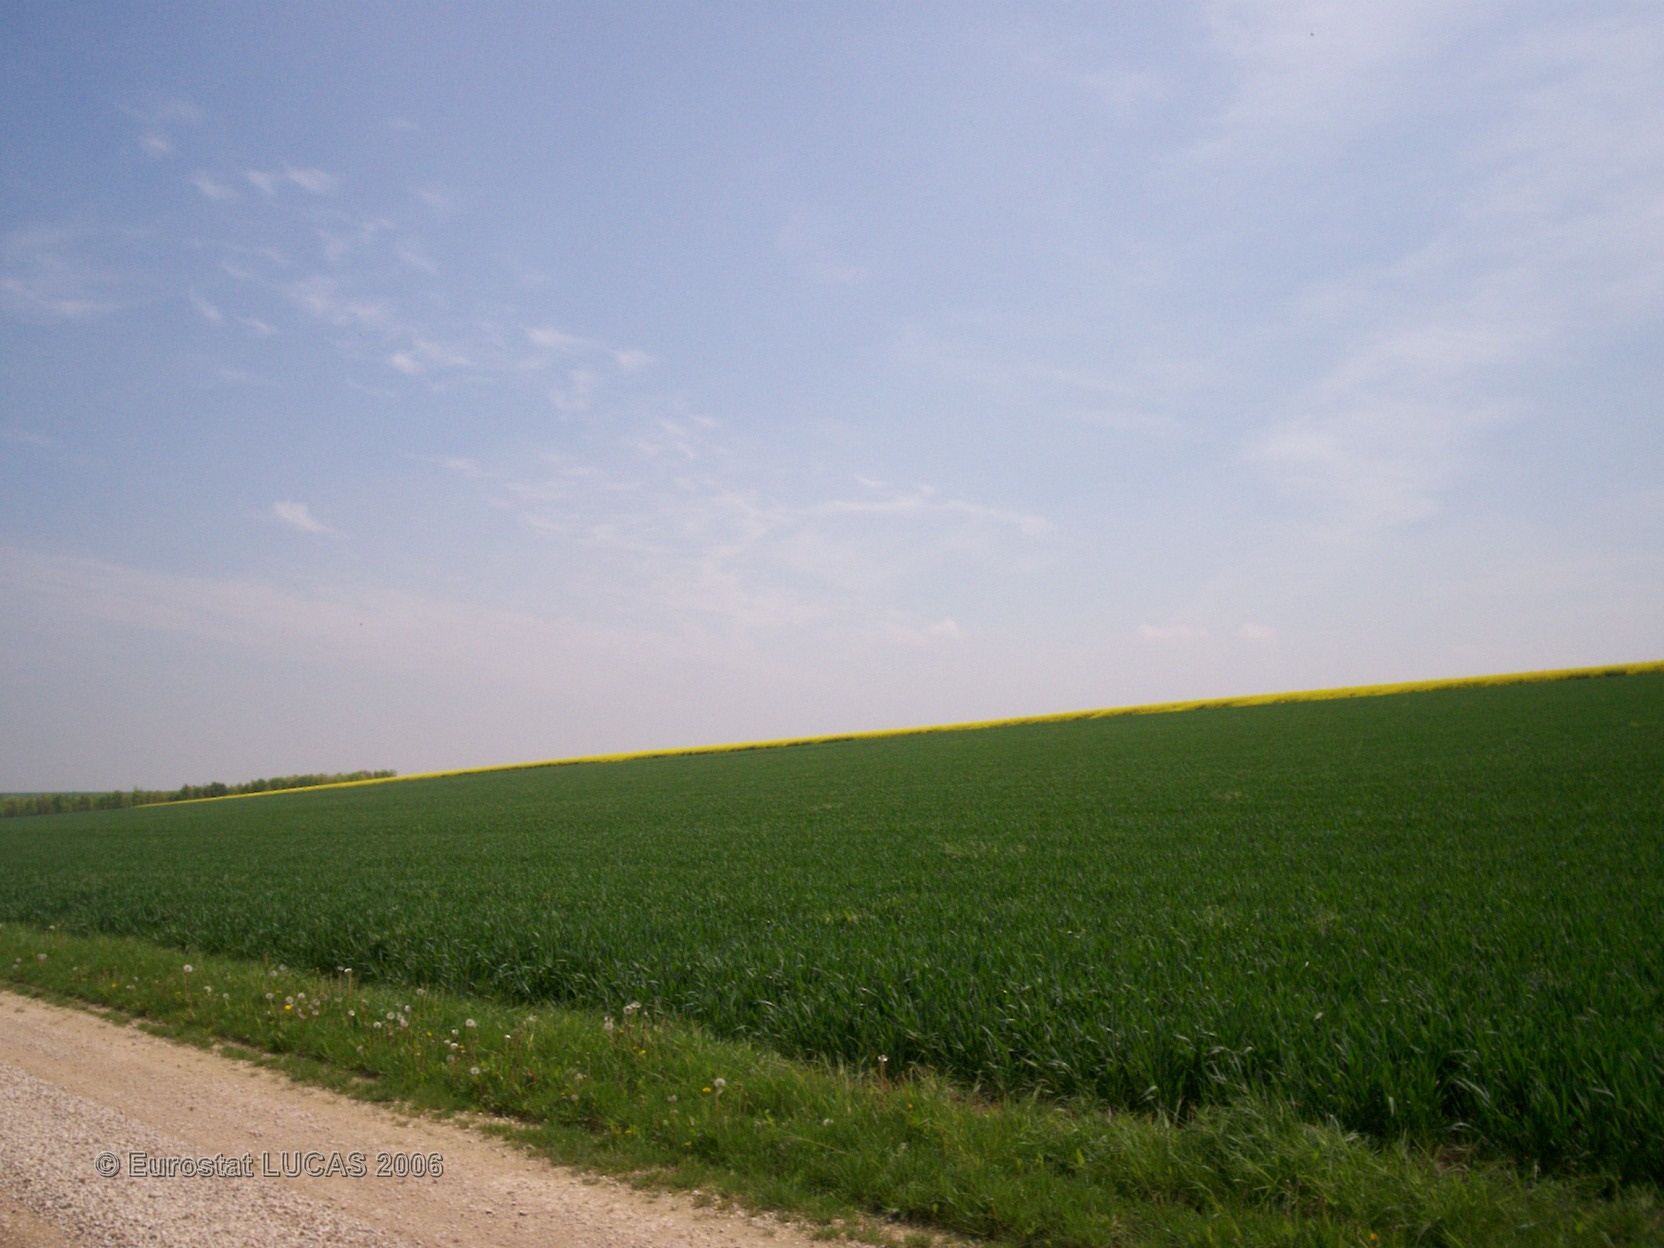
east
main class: Cropland
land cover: Rape and turnip rape
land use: Agriculture (excluding fallow land and kitchen gardens)
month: May
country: FR
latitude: 49.0040
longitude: 4.4602
